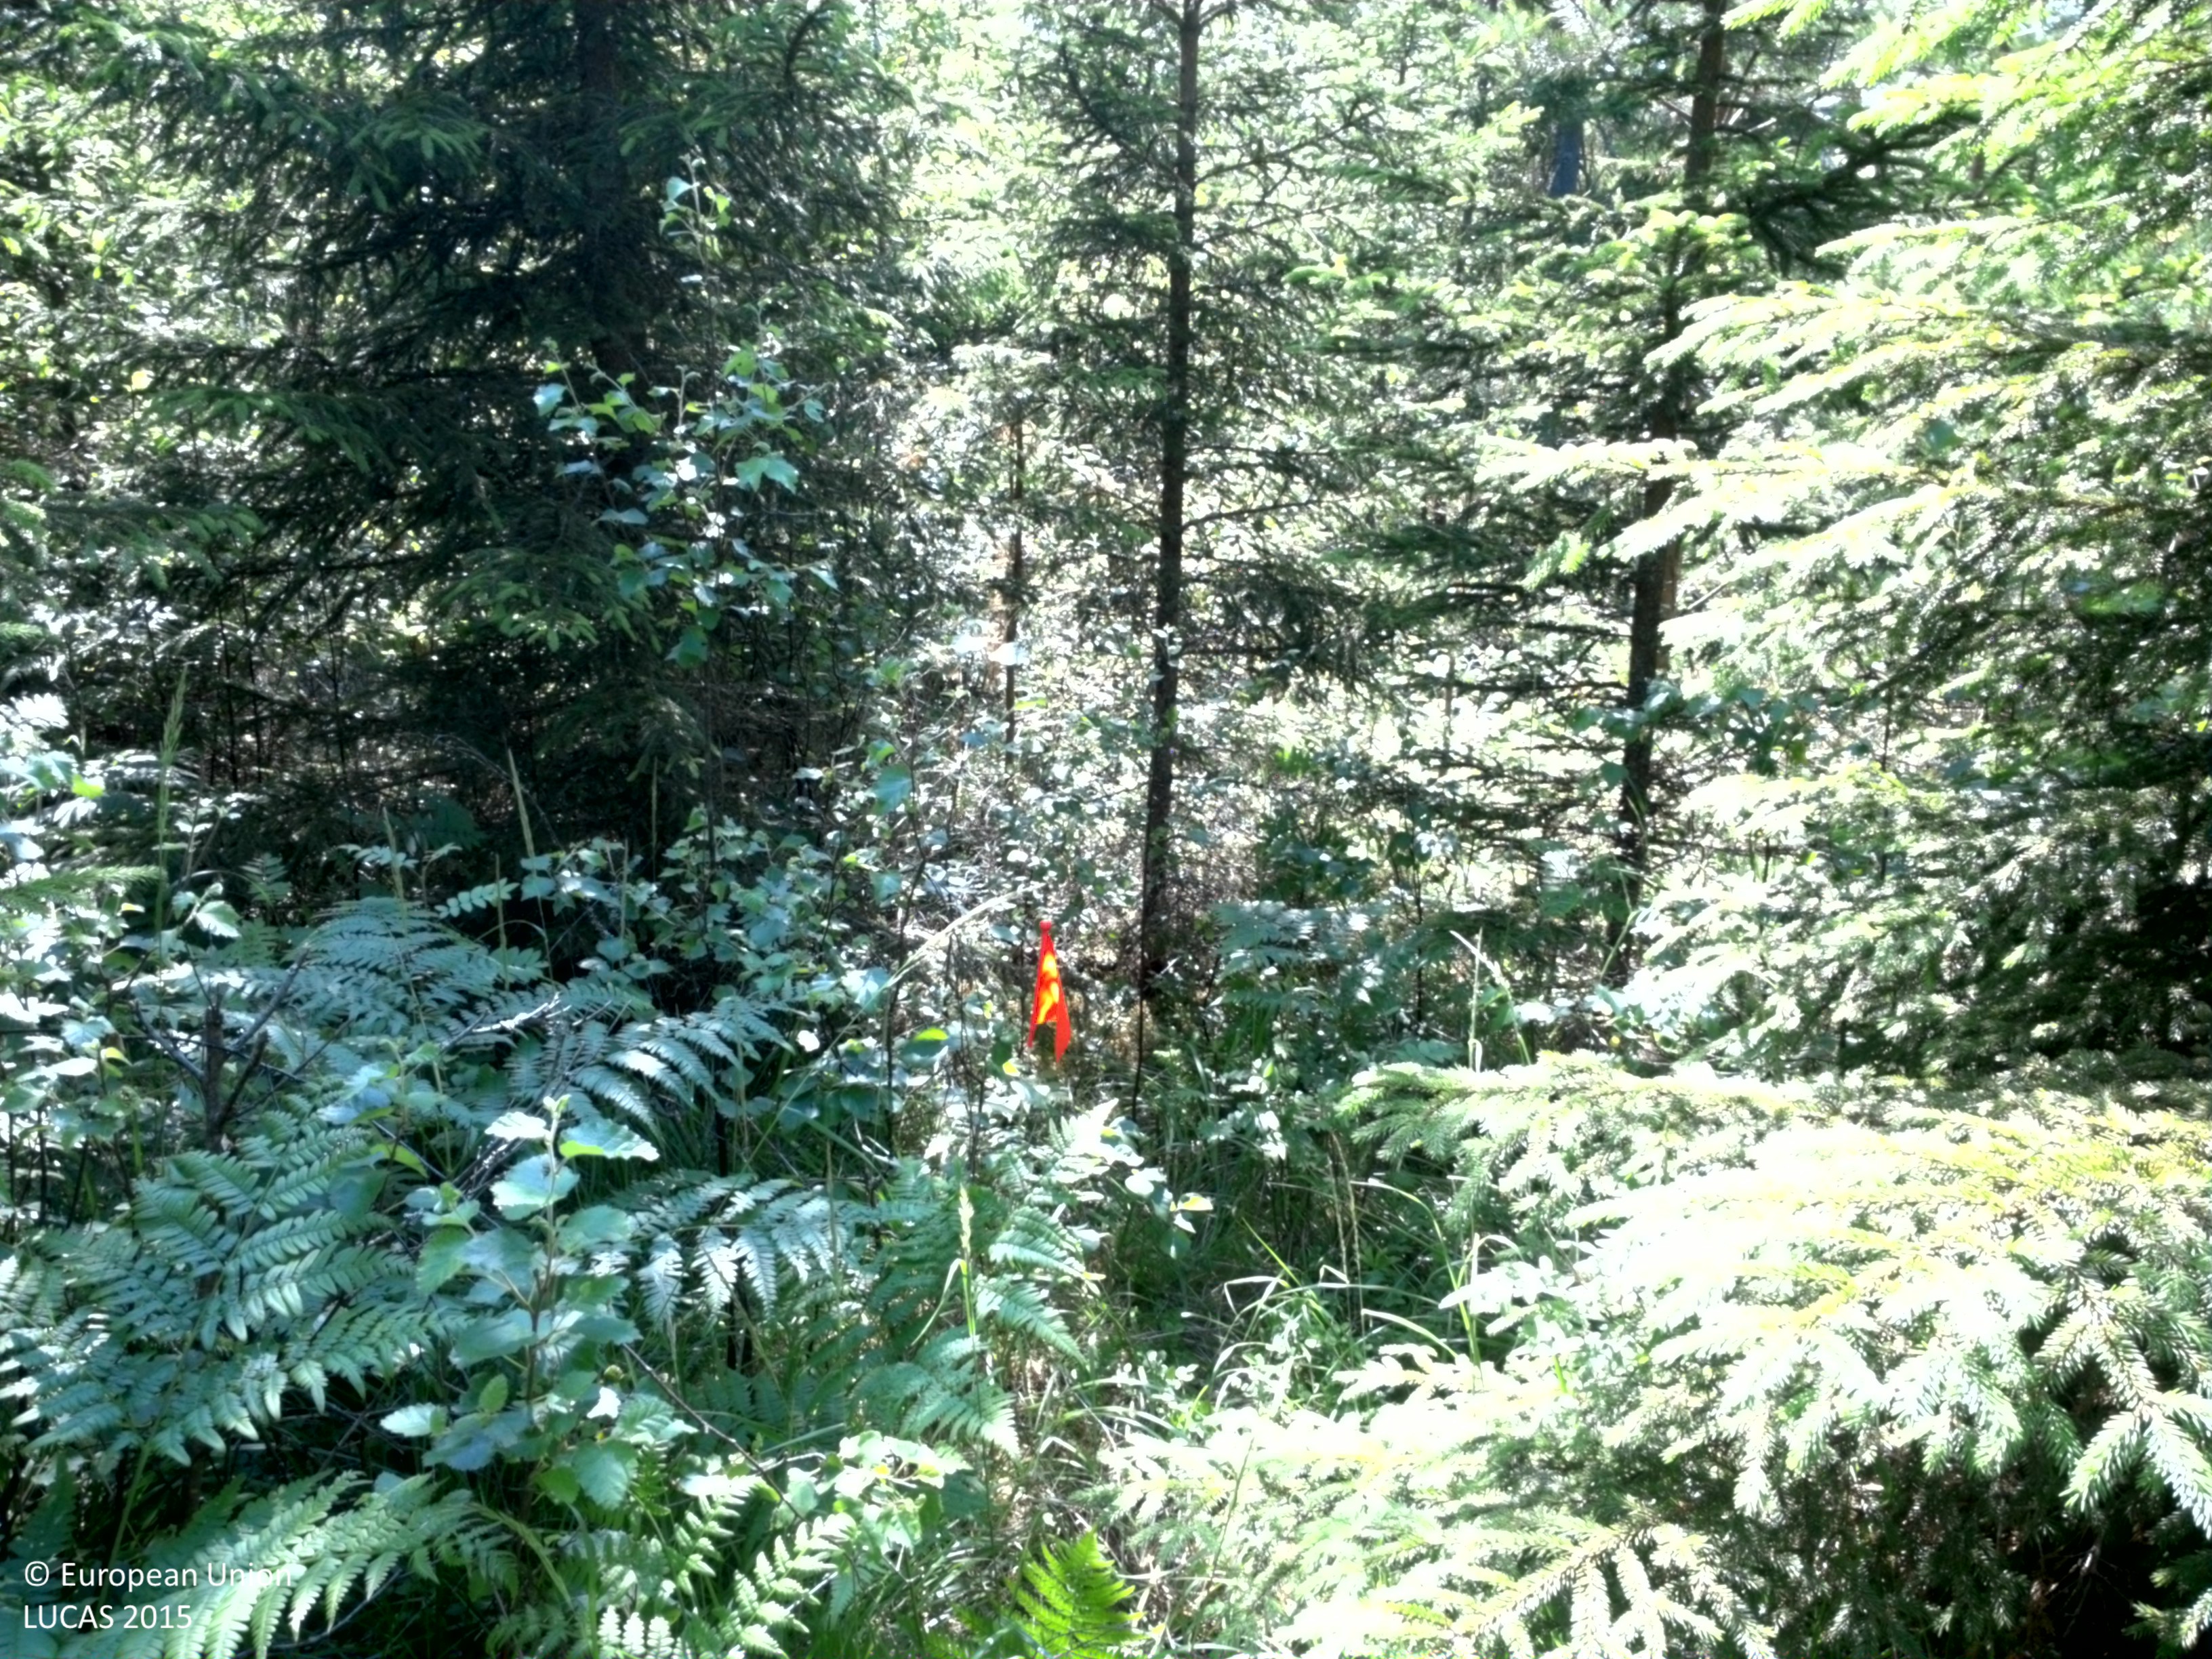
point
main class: Woodland
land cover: Spruce dominated mixed woodland
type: boreal forest
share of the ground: > 75 %
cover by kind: coniferous forest trees 50 %, broadleaved forest trees 30 %, herbaceous plants 15 %, shrubs 5 %
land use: Forestry
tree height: < 5 m
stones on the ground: < 10 %
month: July
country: SE
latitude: 59.1157
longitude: 14.5506
